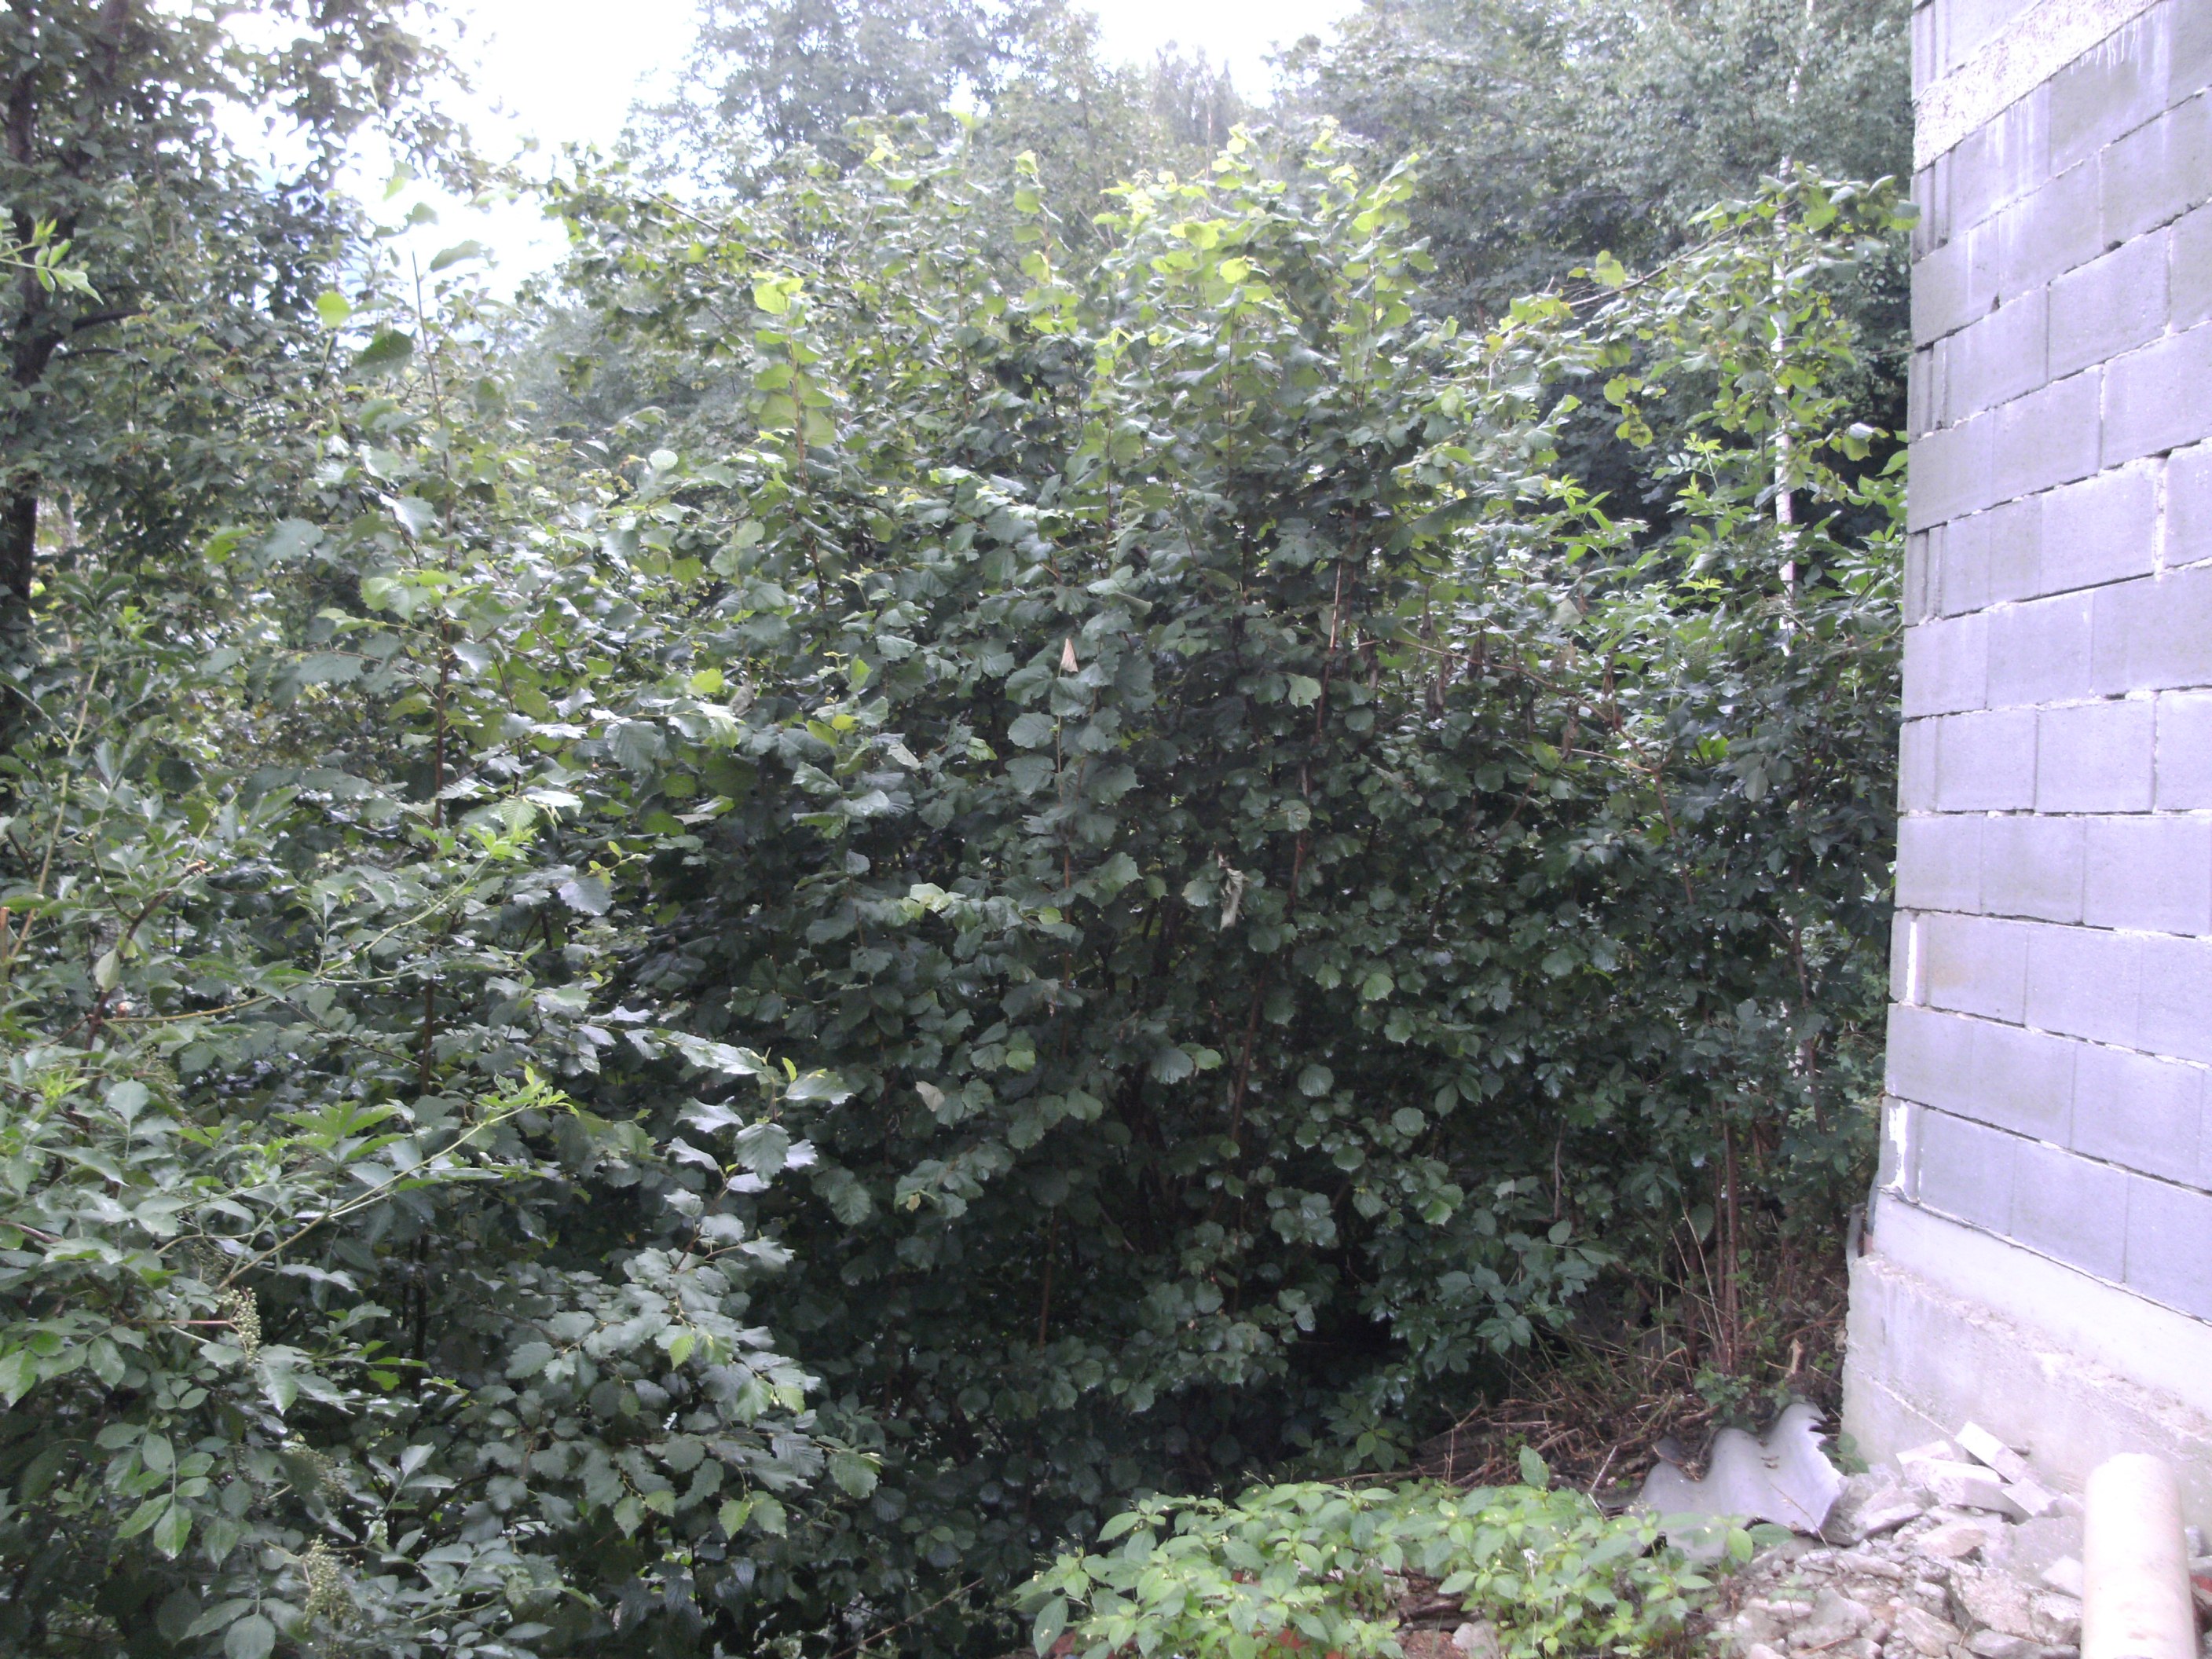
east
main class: Grassland
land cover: Grassland with sparse tree/shrub cover
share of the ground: > 75 %
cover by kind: herbaceous plants 95 %, broadleaved forest trees 5 %
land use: Forestry
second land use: Residential
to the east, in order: Grassland with sparse tree/shrub cover; Broadleaved woodland; Tracks; Fences; Broadleaved woodland; Rivers and streams; Broadleaved woodland; Fences; Grassland without tree/shrub cover; Electric lines; Grassland without tree/shrub cover; Fences; Spruce dominated mixed woodland; Electric lines; Tracks; Ditches and canals; Spruce dominated mixed woodland; Tracks; Spruce dominated mixed woodland; Spruce dominated coniferous woodland; Paved roads, cycling and walking lanes
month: July
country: AT
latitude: 46.8707
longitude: 14.8921
